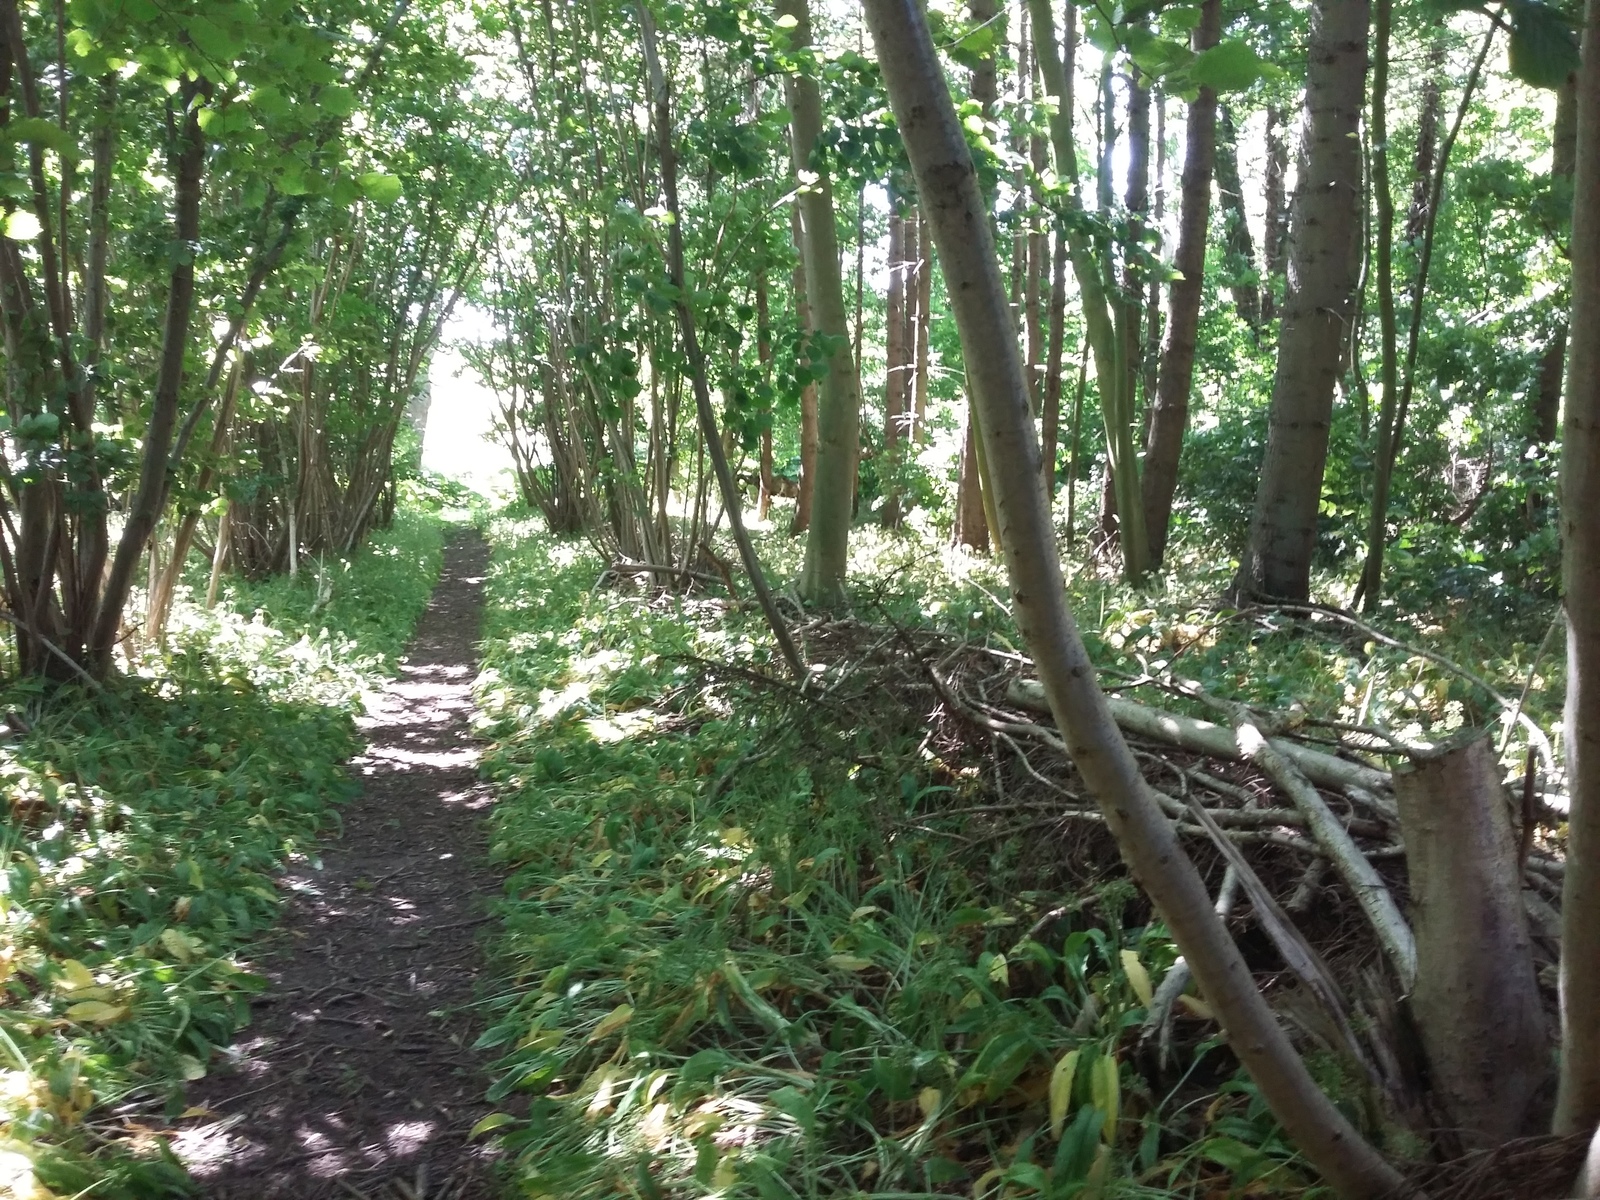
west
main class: Woodland
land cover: Broadleaved woodland
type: beech forest
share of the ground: > 75 %
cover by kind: broadleaved forest trees 80 %, coniferous forest trees 10 %, herbaceous plants 10 %
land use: Forestry
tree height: > 5 m
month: July
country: DK
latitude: 55.0392
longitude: 12.0173
